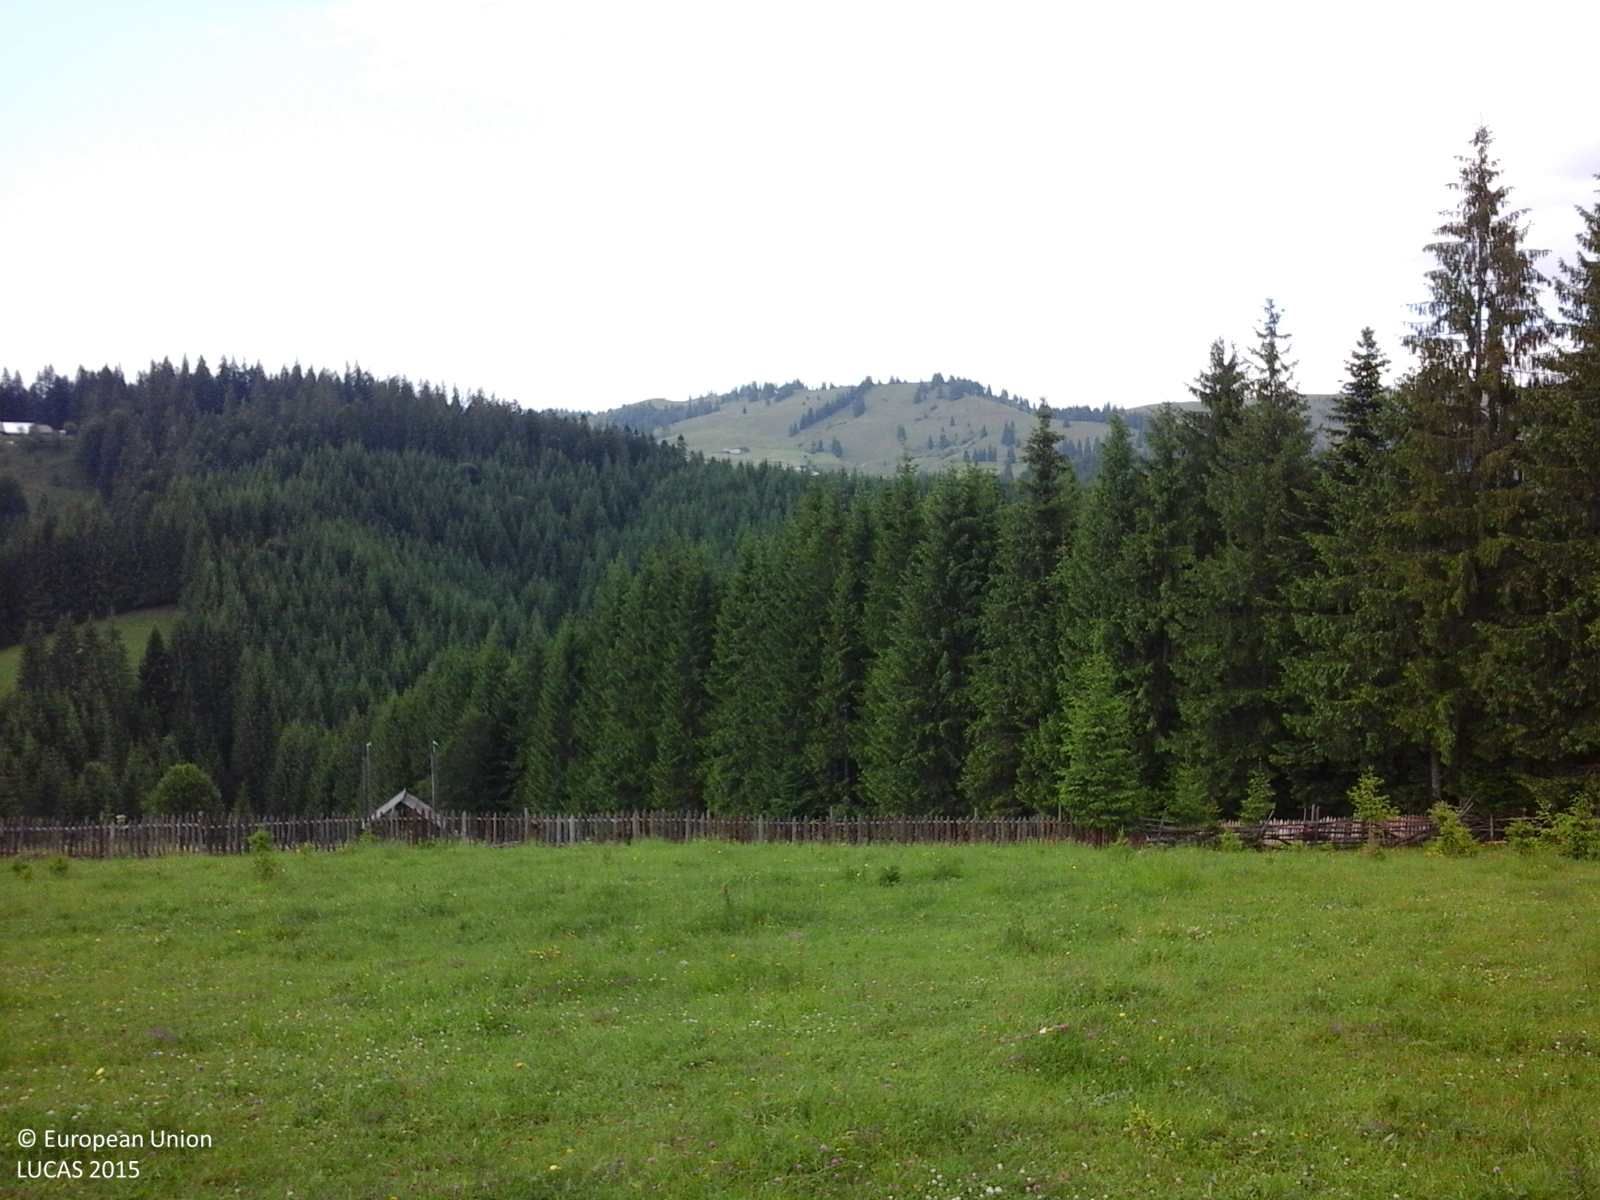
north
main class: Grassland
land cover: Grassland without tree/shrub cover
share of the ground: > 75 %
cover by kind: herbaceous plants 100 %
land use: Agriculture (excluding fallow land and kitchen gardens)
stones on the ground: < 10 %
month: June
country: RO
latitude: 47.8497
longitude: 25.2539
